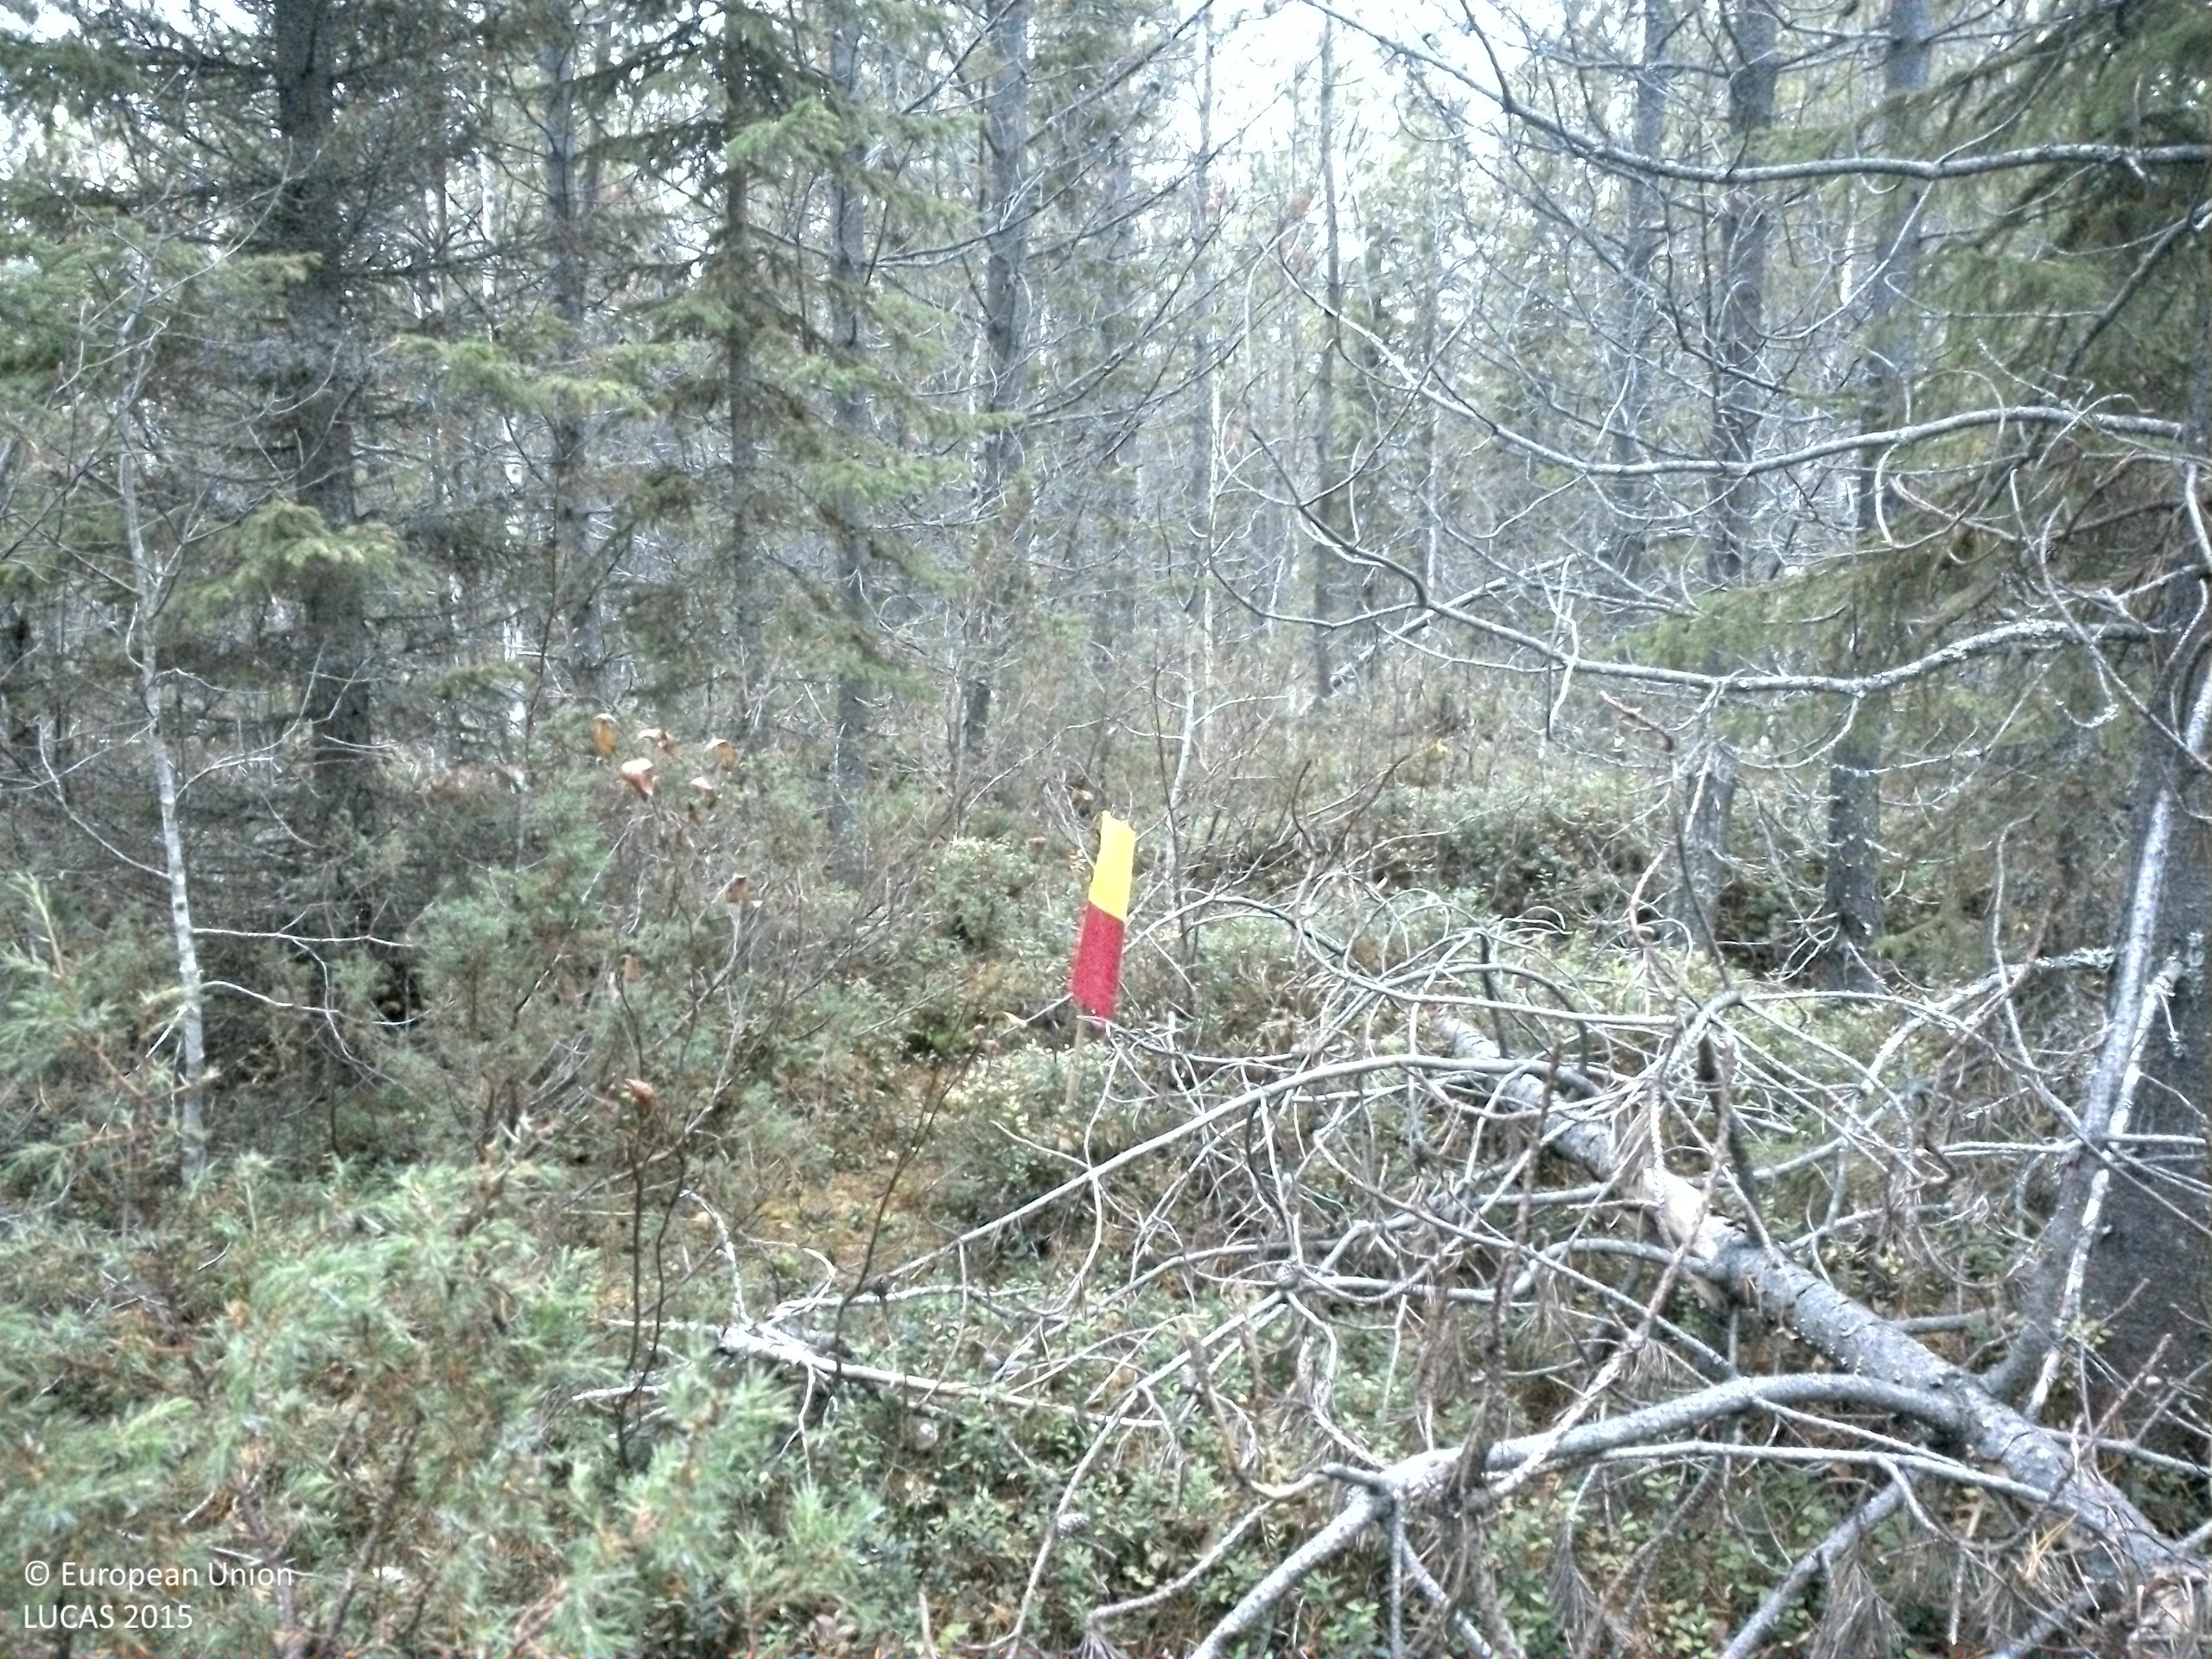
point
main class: Woodland
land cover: Pine dominated mixed woodland
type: exotic forest
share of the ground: 50 - 75 %
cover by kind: coniferous forest trees 40 %, shrubs 25 %, broadleaved forest trees 15 %, lichens and mosses 15 %, herbaceous plants 5 %
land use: Forestry
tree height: > 5 m
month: October
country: SE
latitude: 64.2809
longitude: 15.6093
